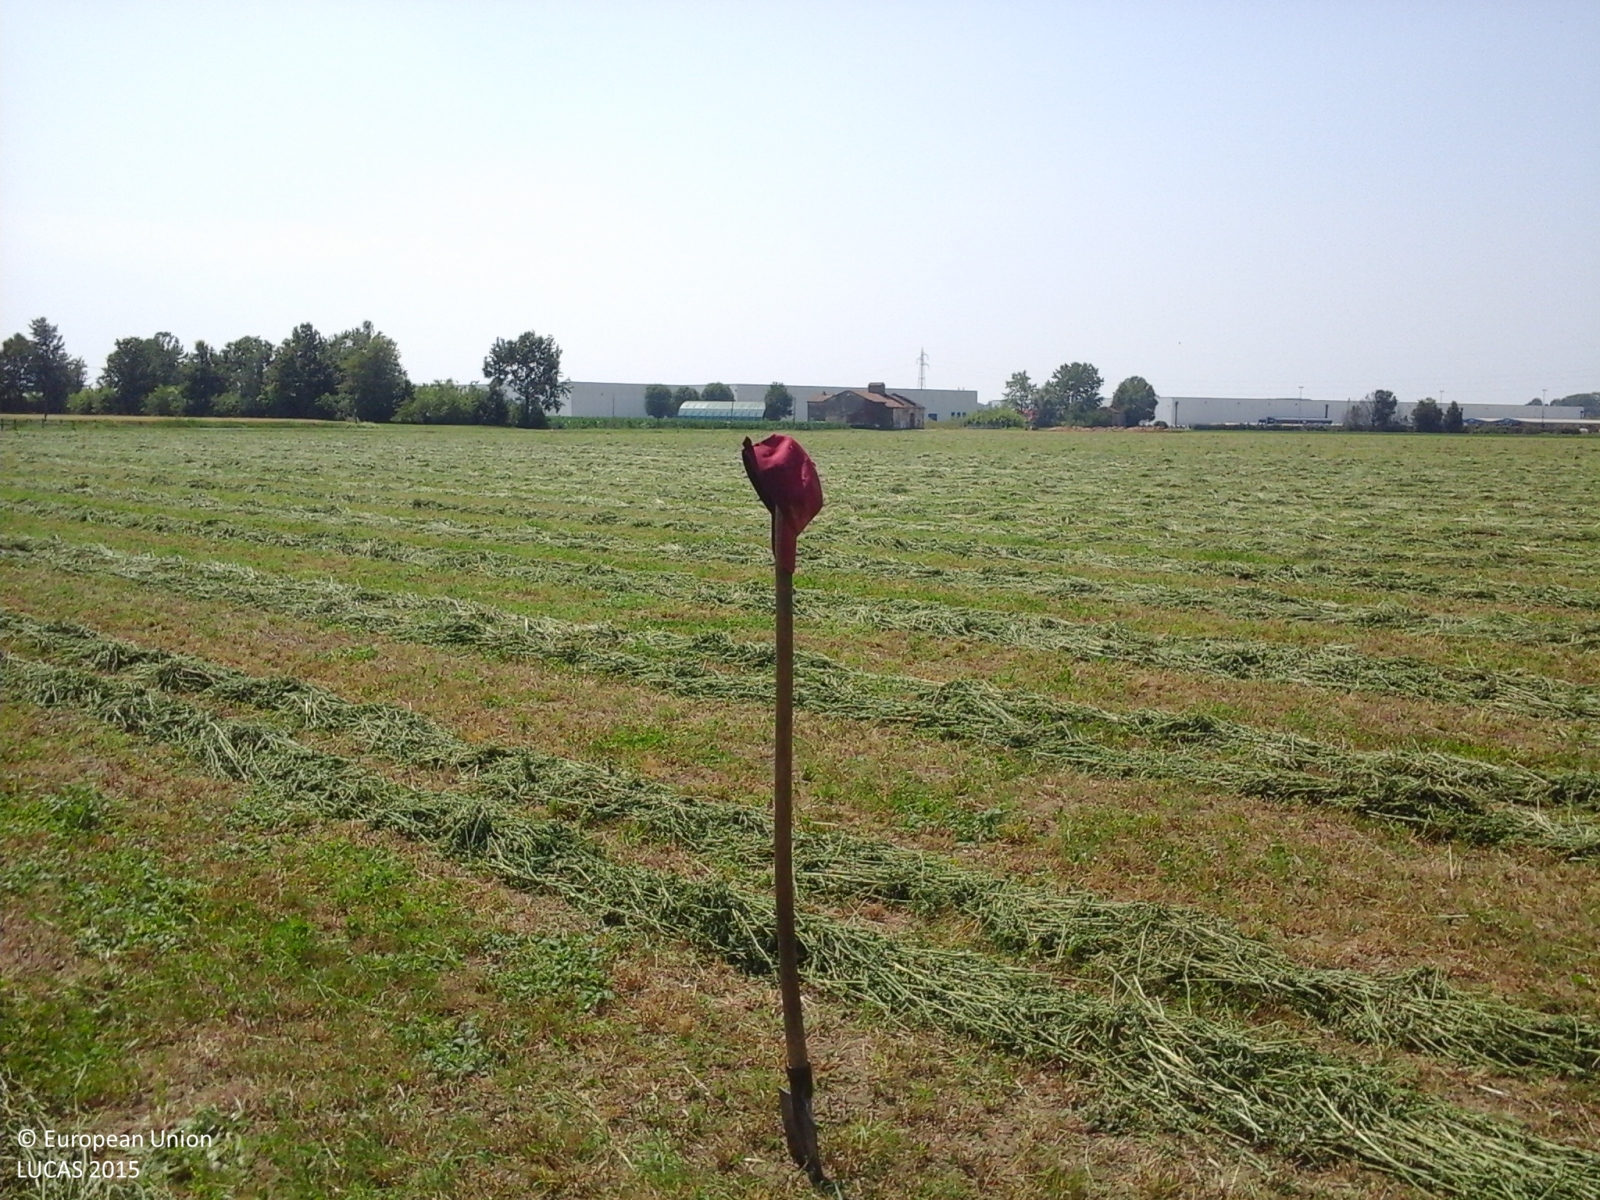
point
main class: Cropland
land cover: Lucerne
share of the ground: > 75 %
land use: Agriculture (excluding fallow land and kitchen gardens)
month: June
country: IT
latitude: 45.0718
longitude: 9.9113
